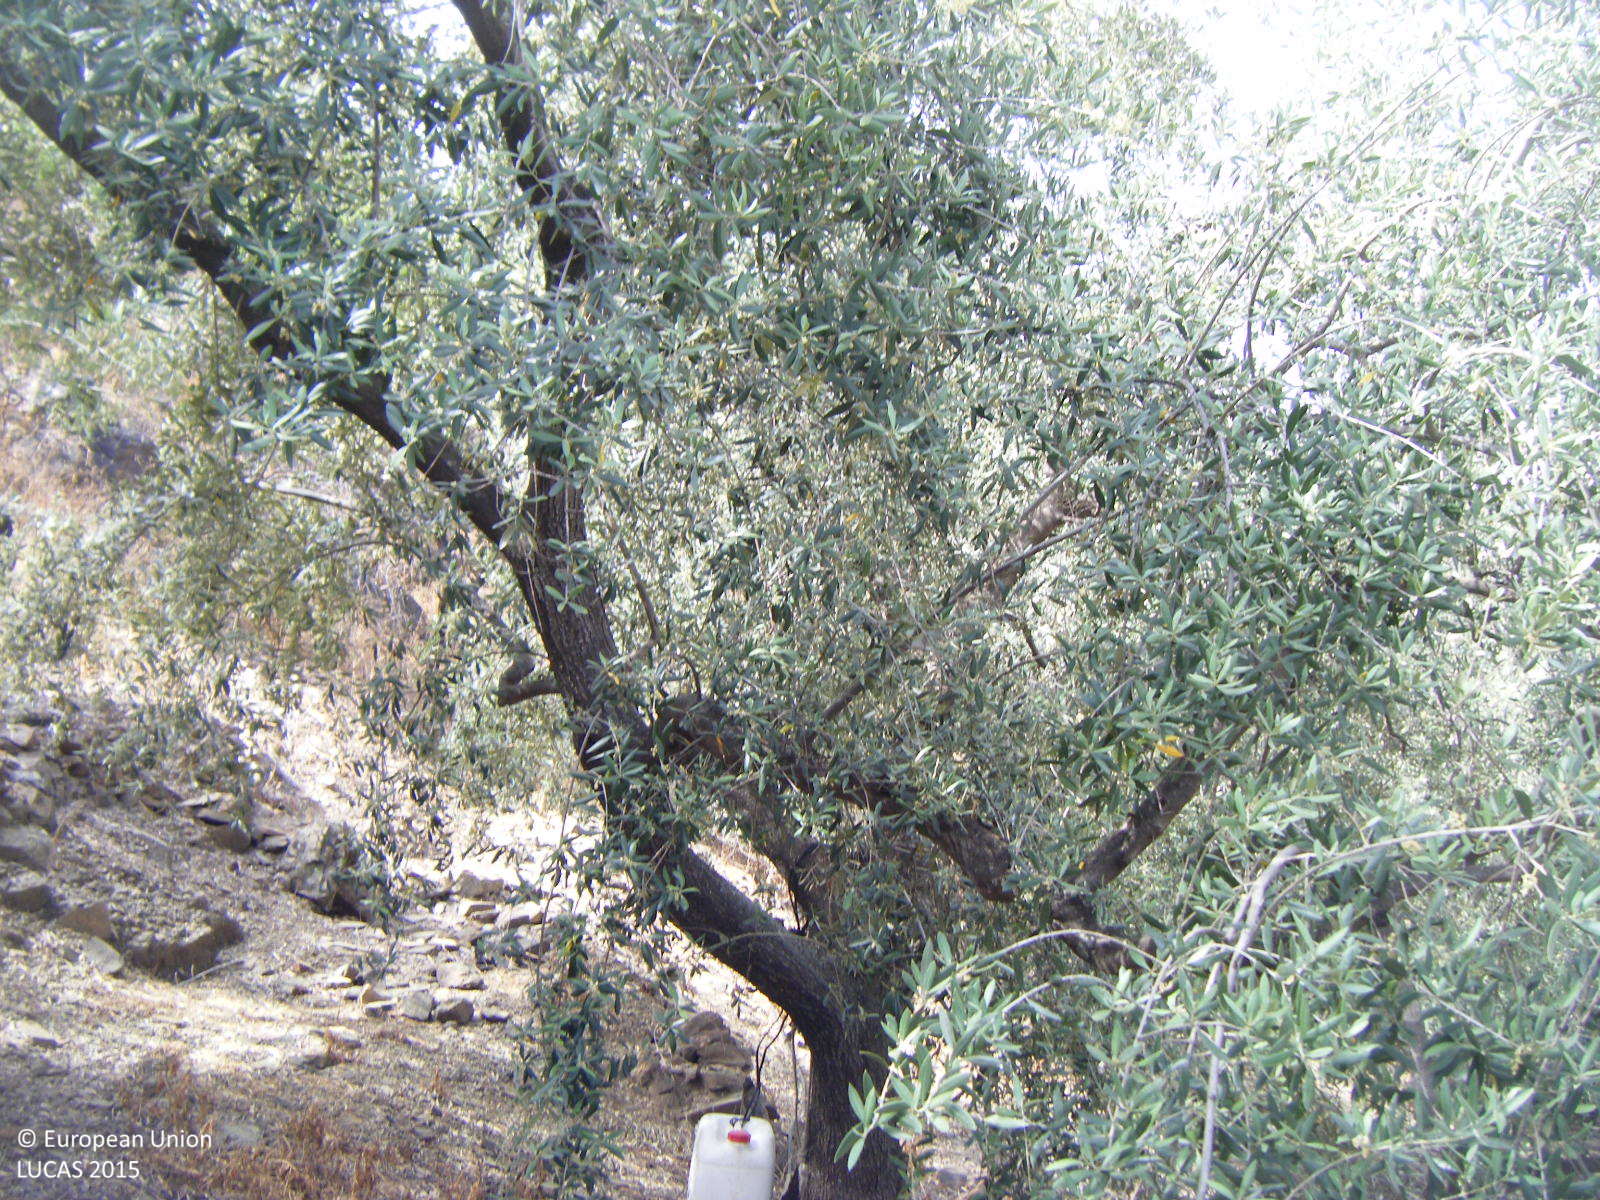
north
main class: Cropland
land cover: Olive groves
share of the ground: 25 - 50 %
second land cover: Other bare soil
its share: > 75 %
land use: Agriculture (excluding fallow land and kitchen gardens)
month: May
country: ES
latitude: 36.8150
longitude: -4.0108
